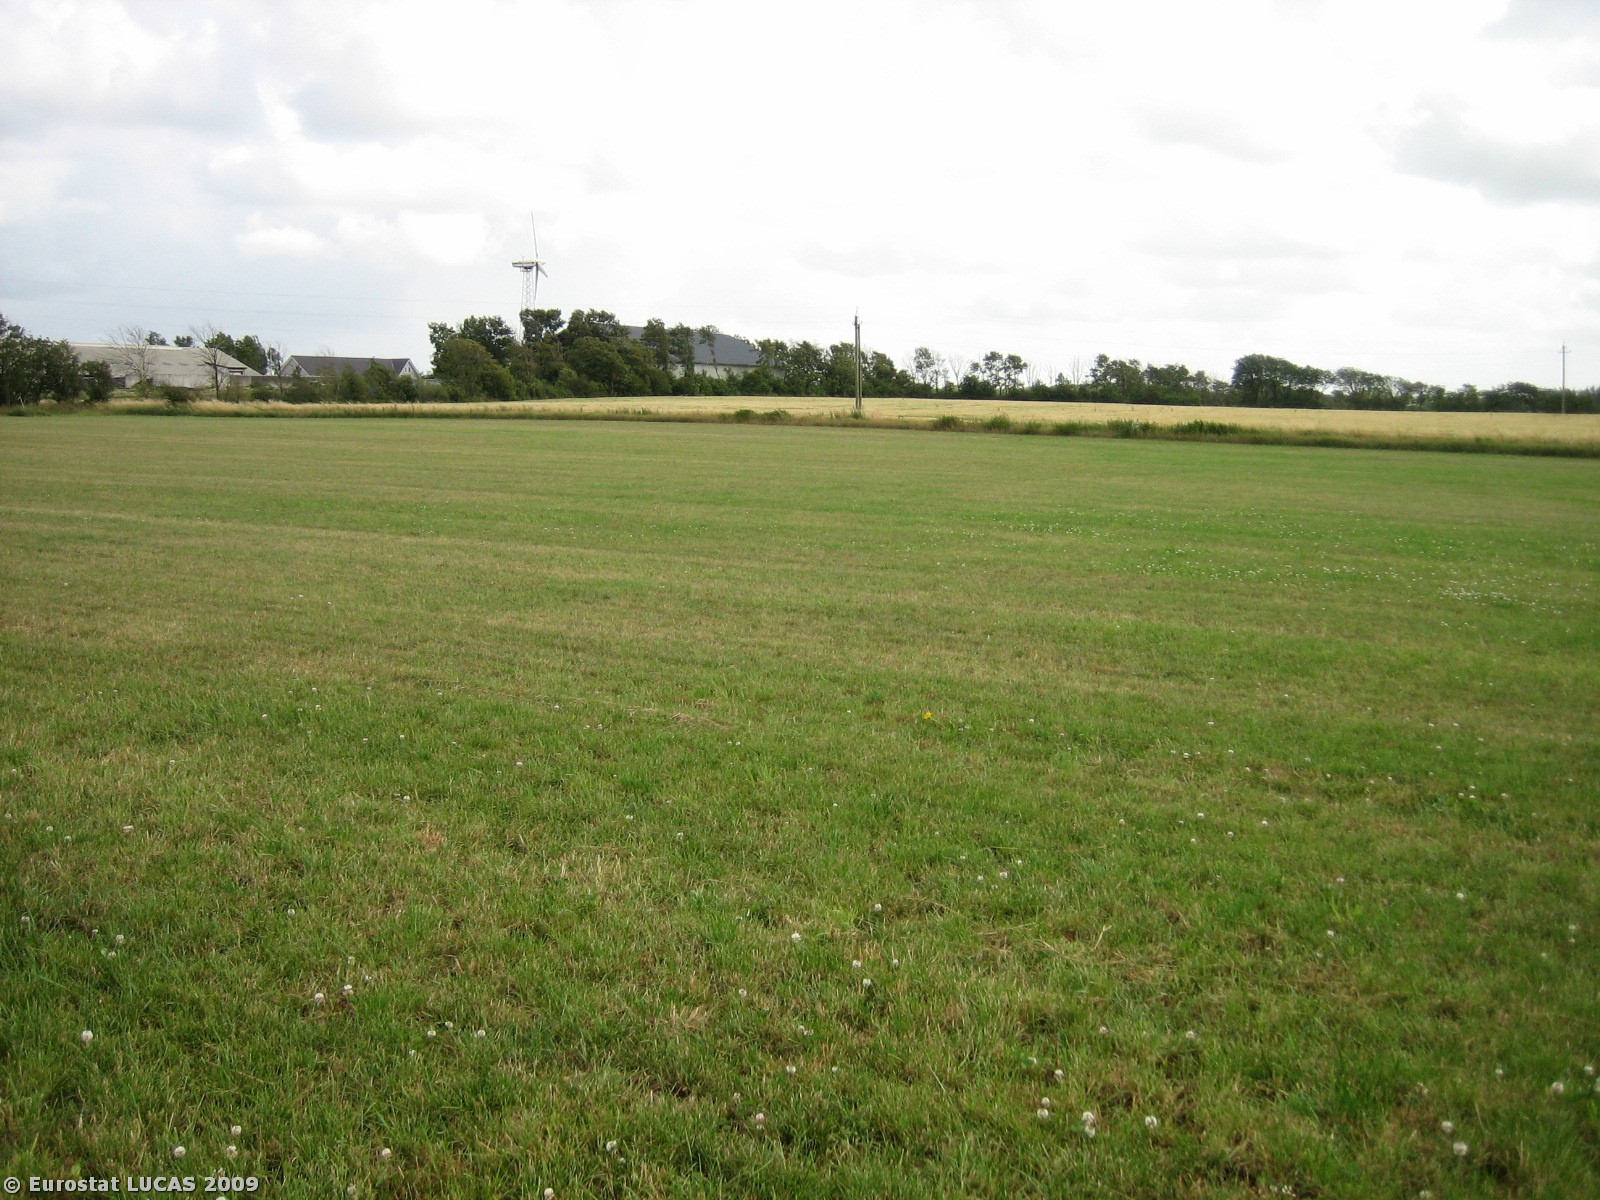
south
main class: Cropland
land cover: Temporary grasslands
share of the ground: > 75 %
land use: Agriculture (excluding fallow land and kitchen gardens)
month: July
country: DK
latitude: 55.7298
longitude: 8.5205
